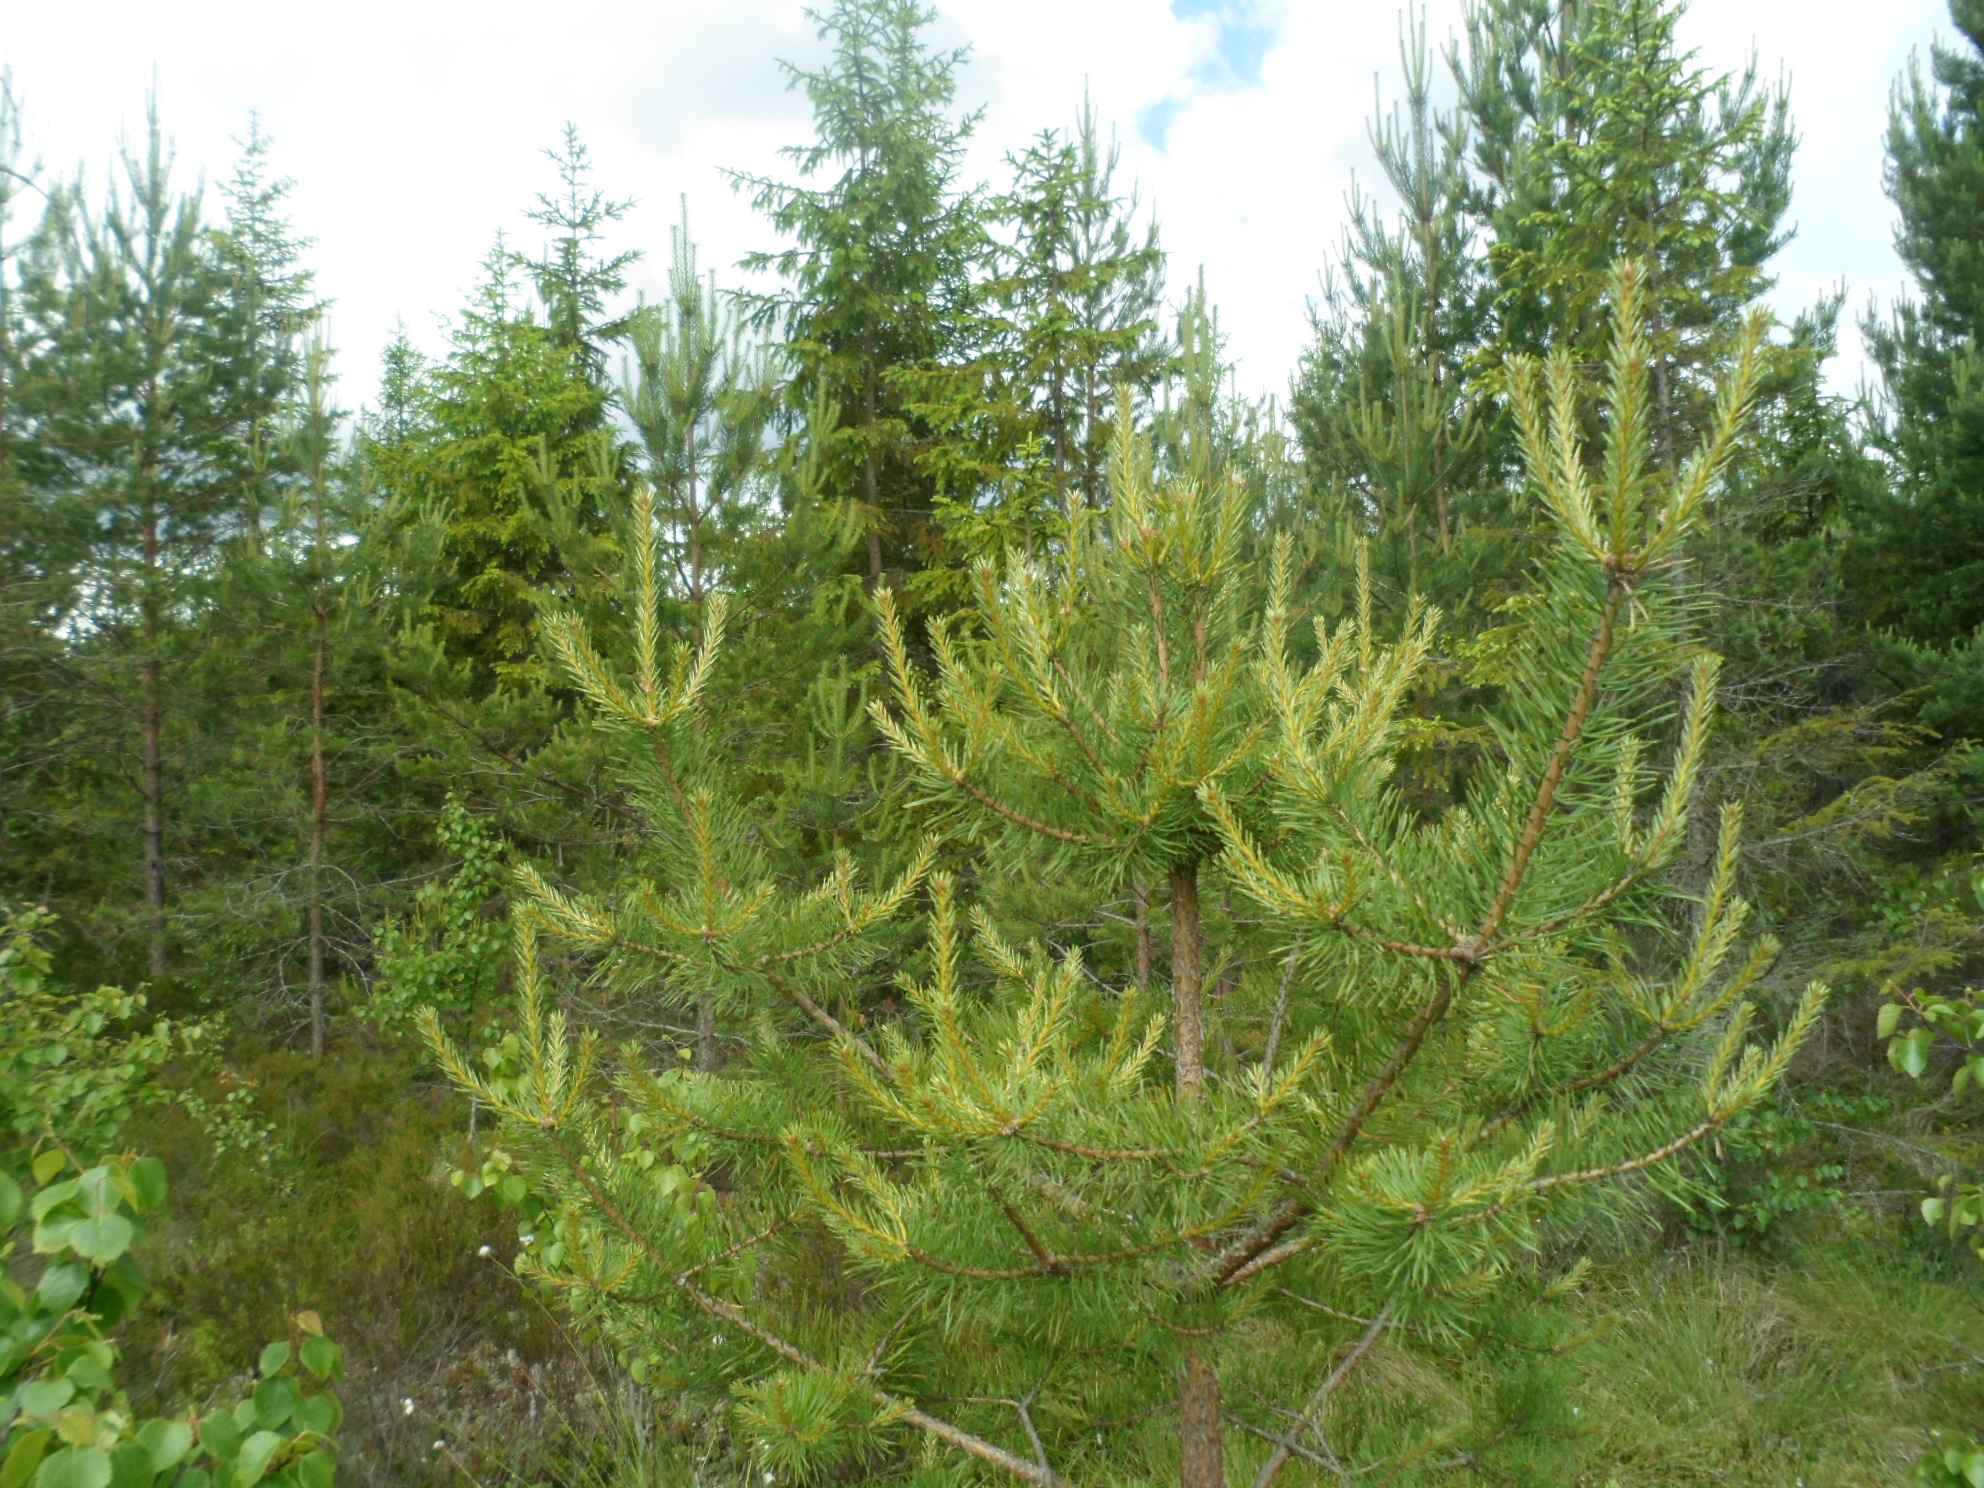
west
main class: Woodland
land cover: Pine dominated mixed woodland
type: boreal forest
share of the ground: 25 - 50 %
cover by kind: lichens and mosses 30 %, coniferous forest trees 20 %, broadleaved forest trees 20 %, shrubs 20 %, herbaceous plants 10 %
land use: Forestry
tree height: > 5 m
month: June
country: SE
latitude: 56.9721
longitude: 15.4759
